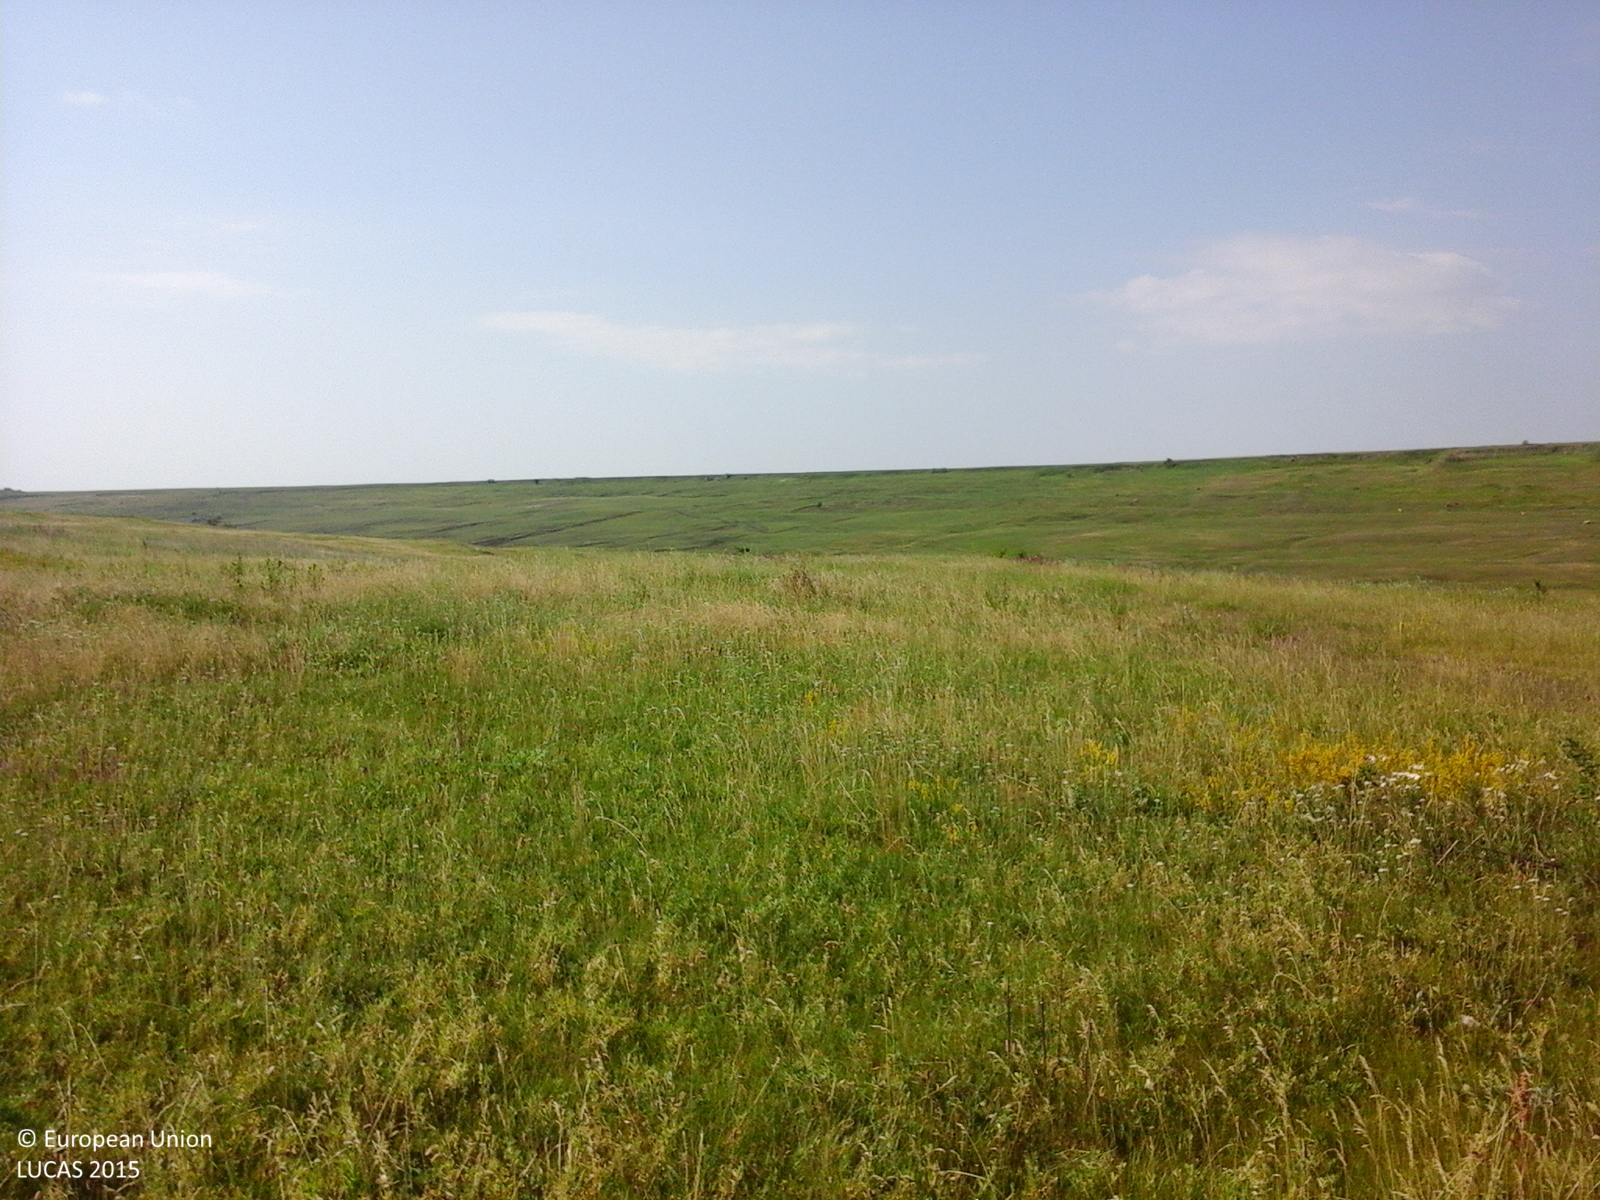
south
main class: Grassland
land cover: Grassland without tree/shrub cover
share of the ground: > 75 %
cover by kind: herbaceous plants 100 %
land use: Agriculture (excluding fallow land and kitchen gardens)
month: June
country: RO
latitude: 47.9542
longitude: 26.6607
